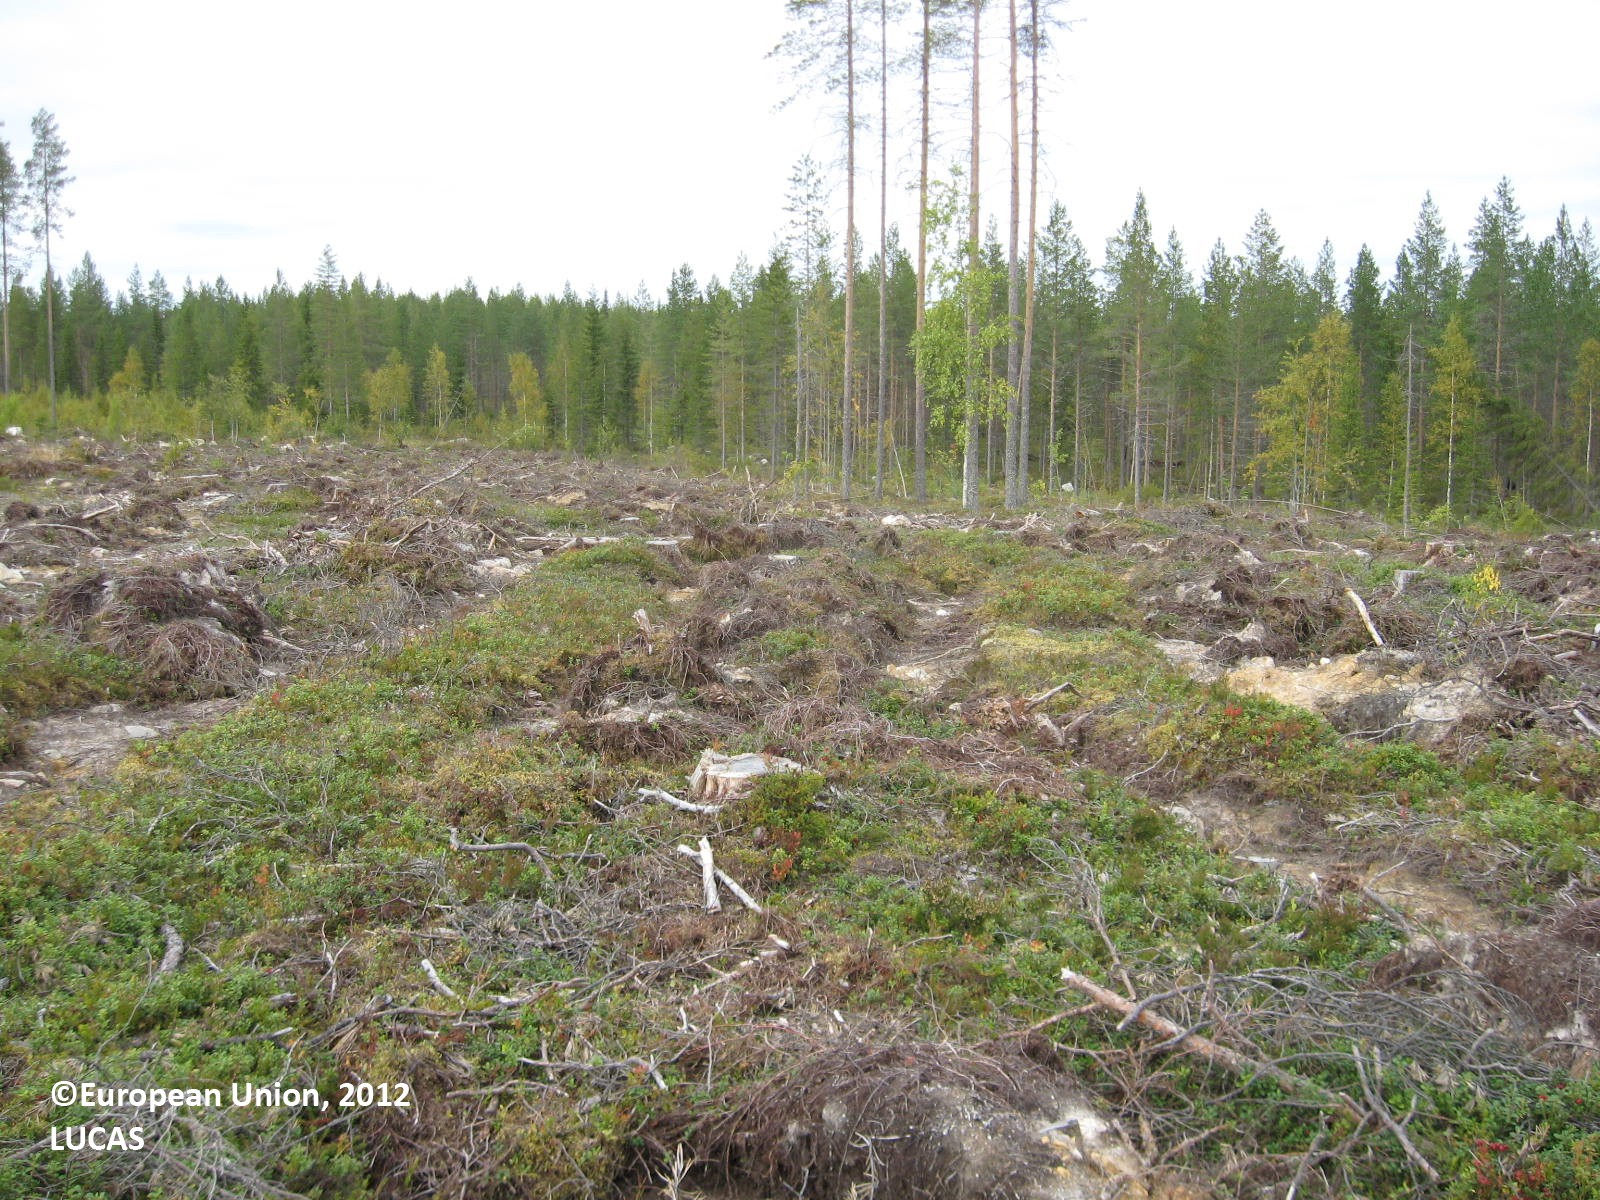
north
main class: Grassland
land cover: Grassland without tree/shrub cover
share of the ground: > 75 %
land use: Forestry
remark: Clear cut
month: August
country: FI
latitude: 63.9707
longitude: 29.2252
